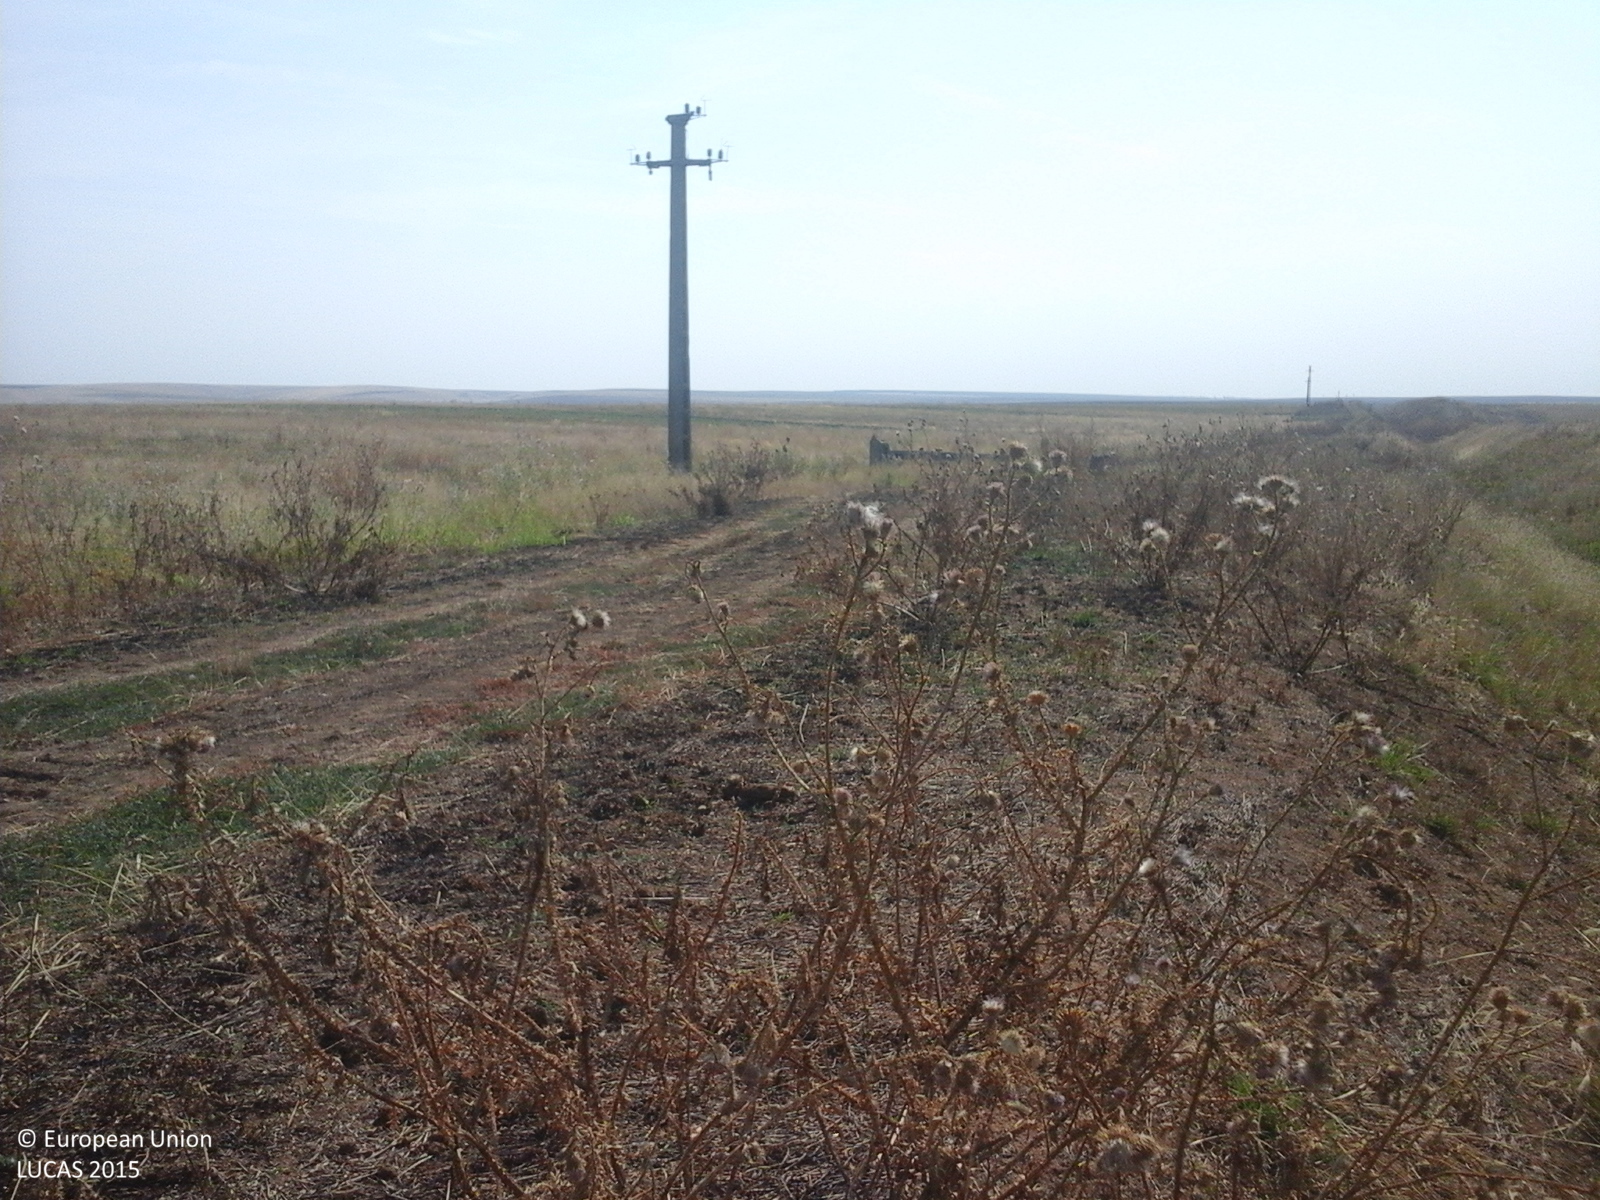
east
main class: Grassland
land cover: Spontaneously vegetated surfaces
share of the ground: > 75 %
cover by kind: herbaceous plants 100 %
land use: Fallow land
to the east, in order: Spontaneously vegetated surfaces; Tracks; Shruby margins; Electric lines; Spontaneously vegetated surfaces; Other bare soil; Spontaneously vegetated surfaces
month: August
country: RO
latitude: 44.2548
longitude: 23.0320
